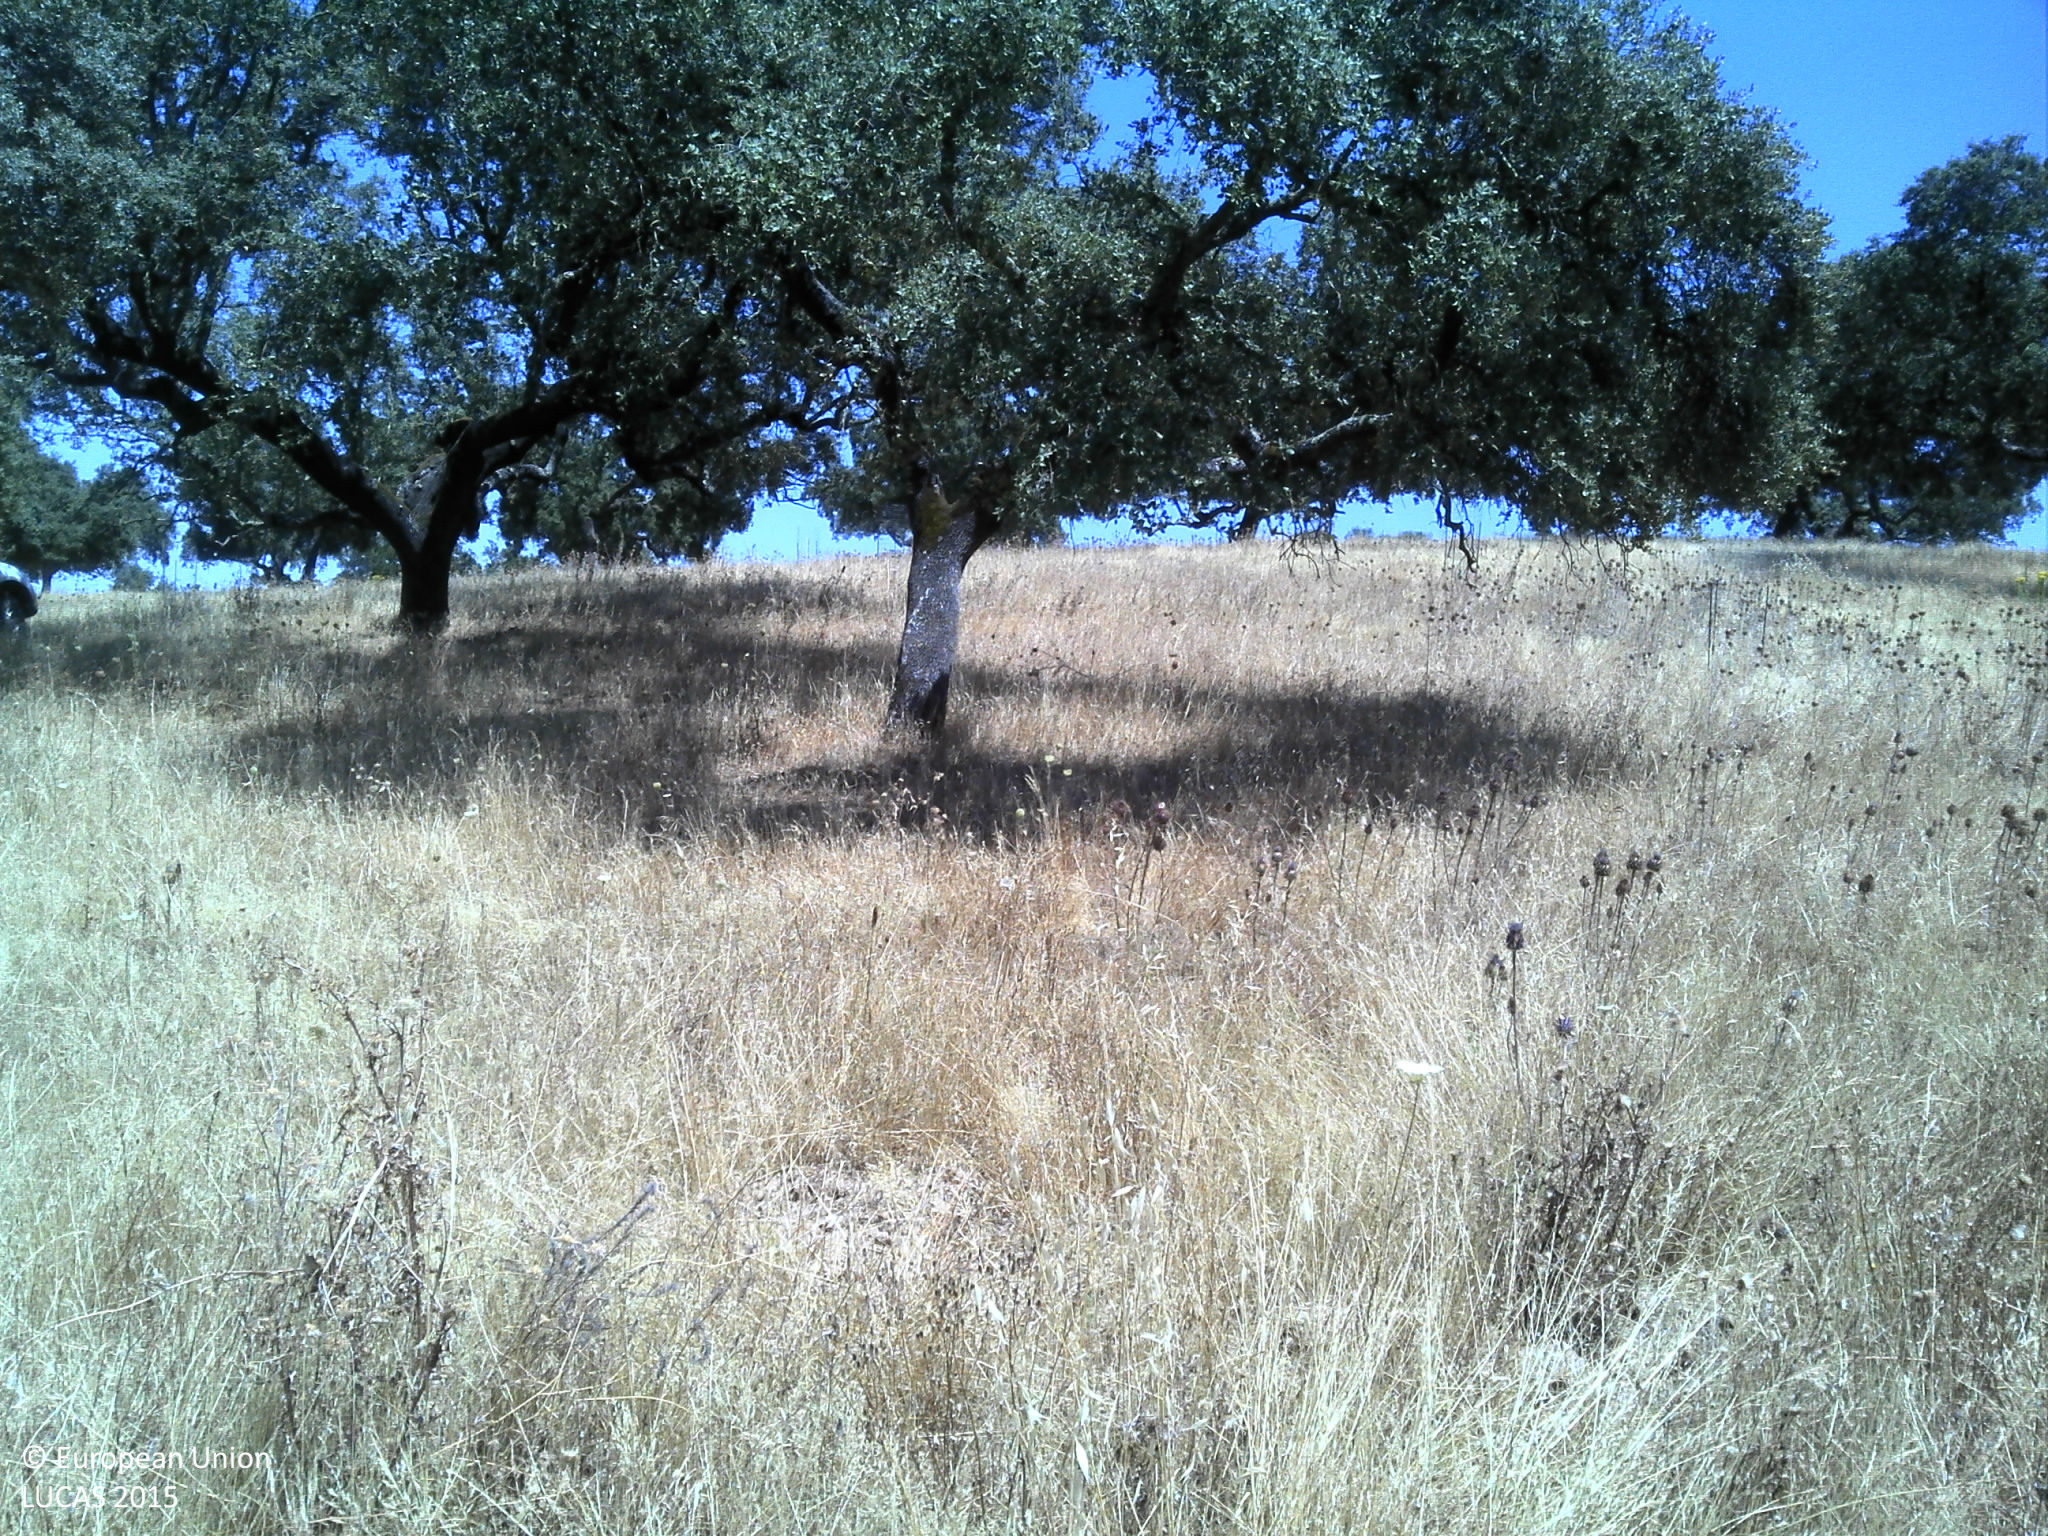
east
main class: Woodland
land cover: Broadleaved woodland
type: broadleaved evergreen forest
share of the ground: 25 - 50 %
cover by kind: herbaceous plants 70 %, broadleaved forest trees 30 %
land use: Forestry
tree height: > 5 m
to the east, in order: Broadleaved woodland; Tracks; Broadleaved woodland
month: June
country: PT
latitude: 37.9990
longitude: -7.2898
